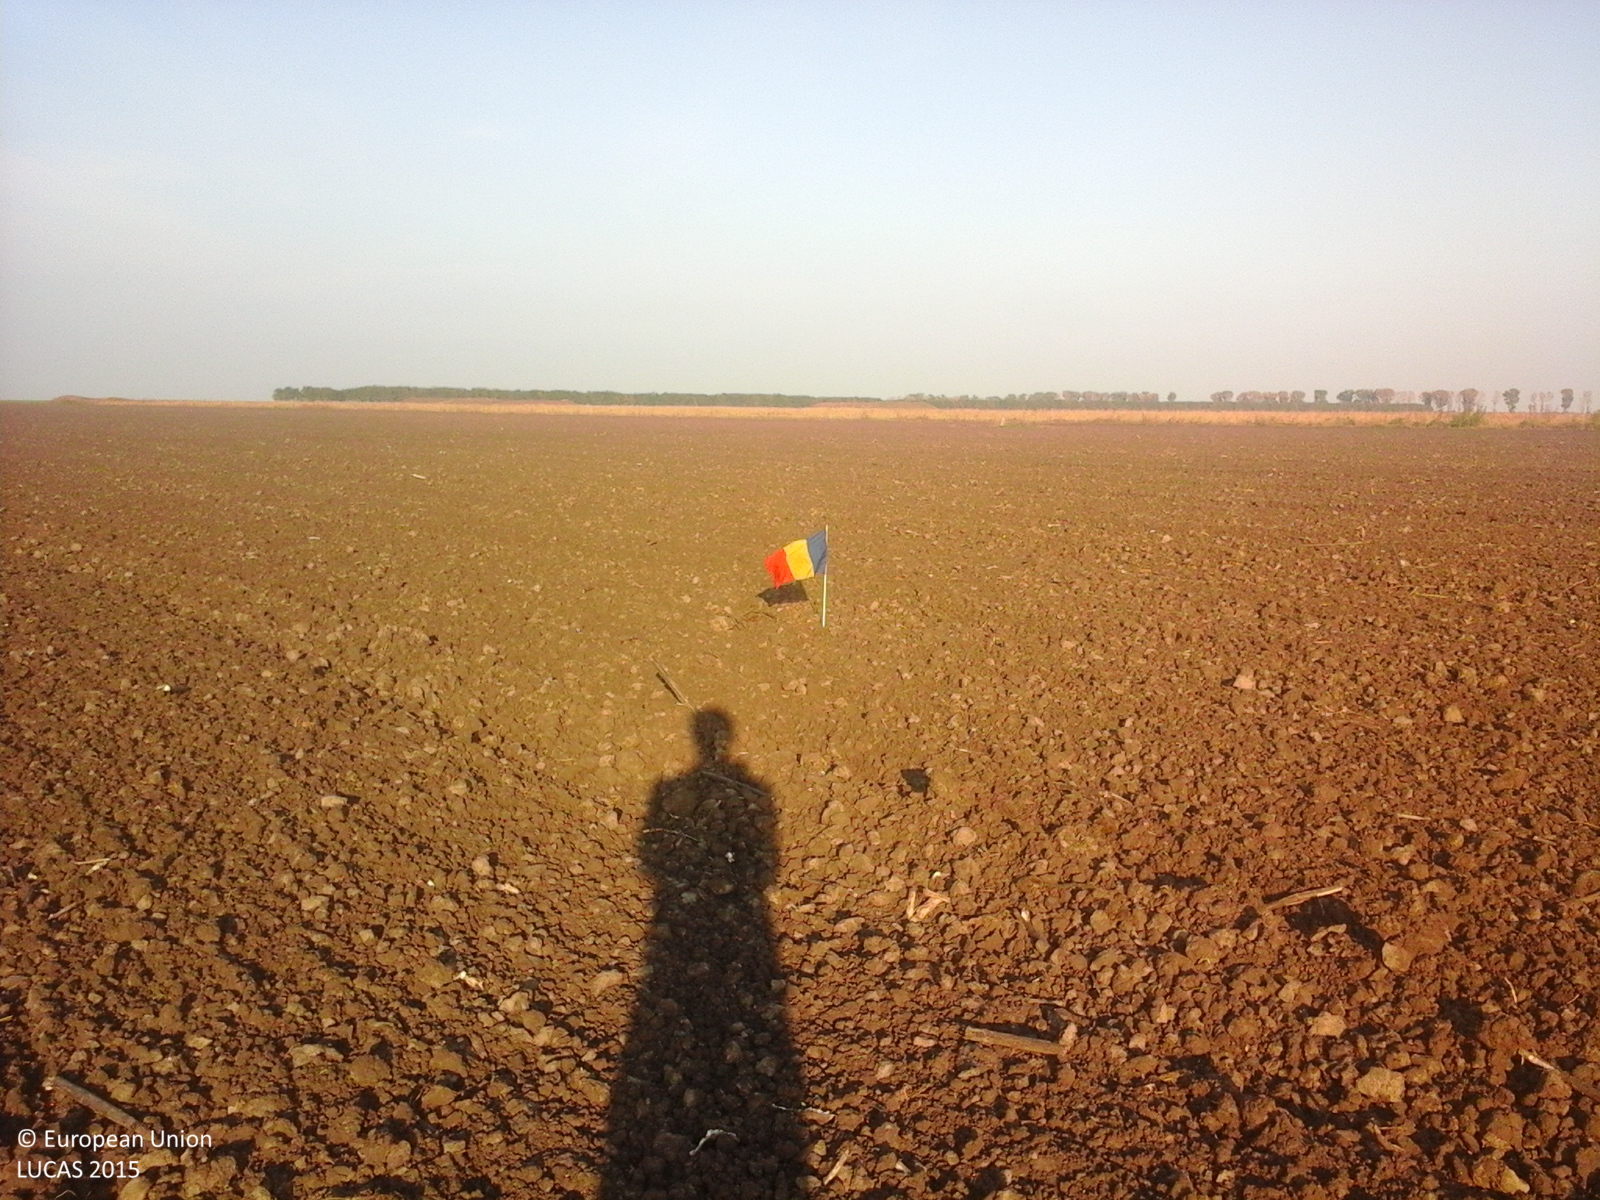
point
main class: Cropland
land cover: Sunflower
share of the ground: < 10 %
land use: Agriculture (excluding fallow land and kitchen gardens)
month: October
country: RO
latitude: 45.2018
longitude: 26.9782
